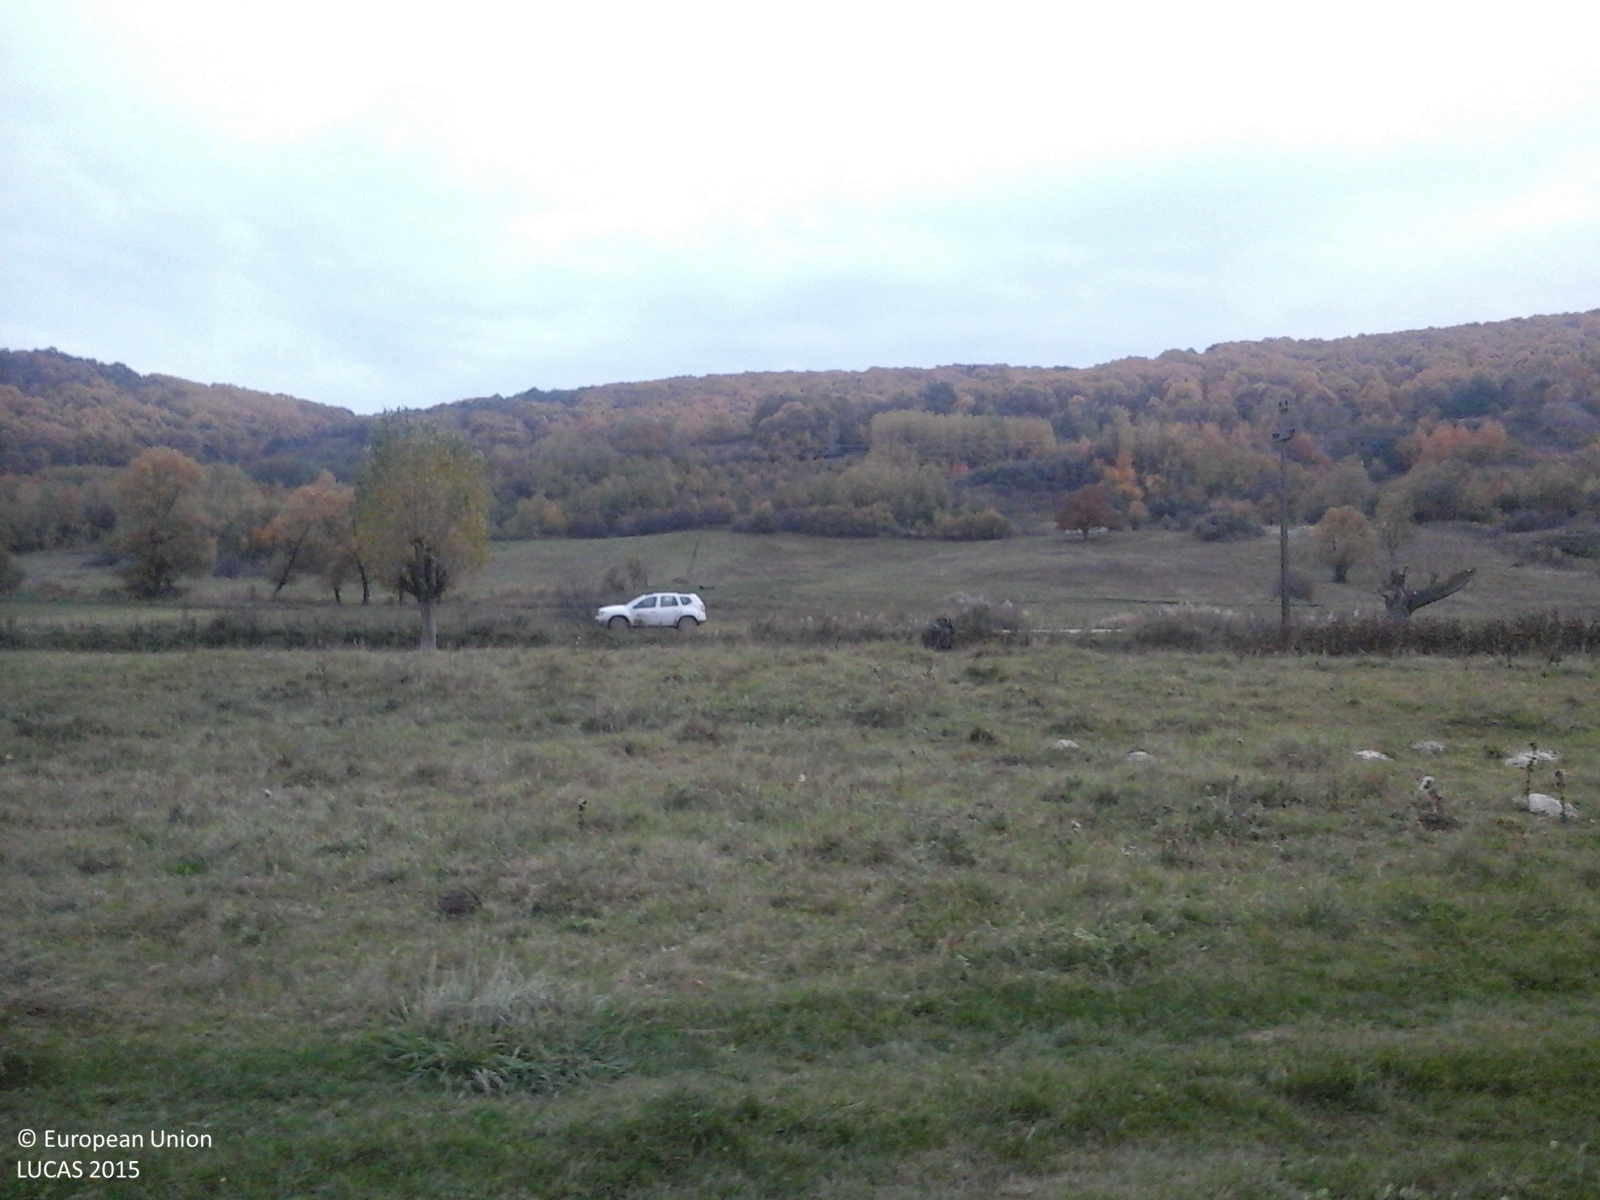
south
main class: Grassland
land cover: Grassland without tree/shrub cover
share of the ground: > 75 %
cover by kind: herbaceous plants 100 %
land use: Agriculture (excluding fallow land and kitchen gardens)
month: October
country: RO
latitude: 45.3958
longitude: 26.8028
